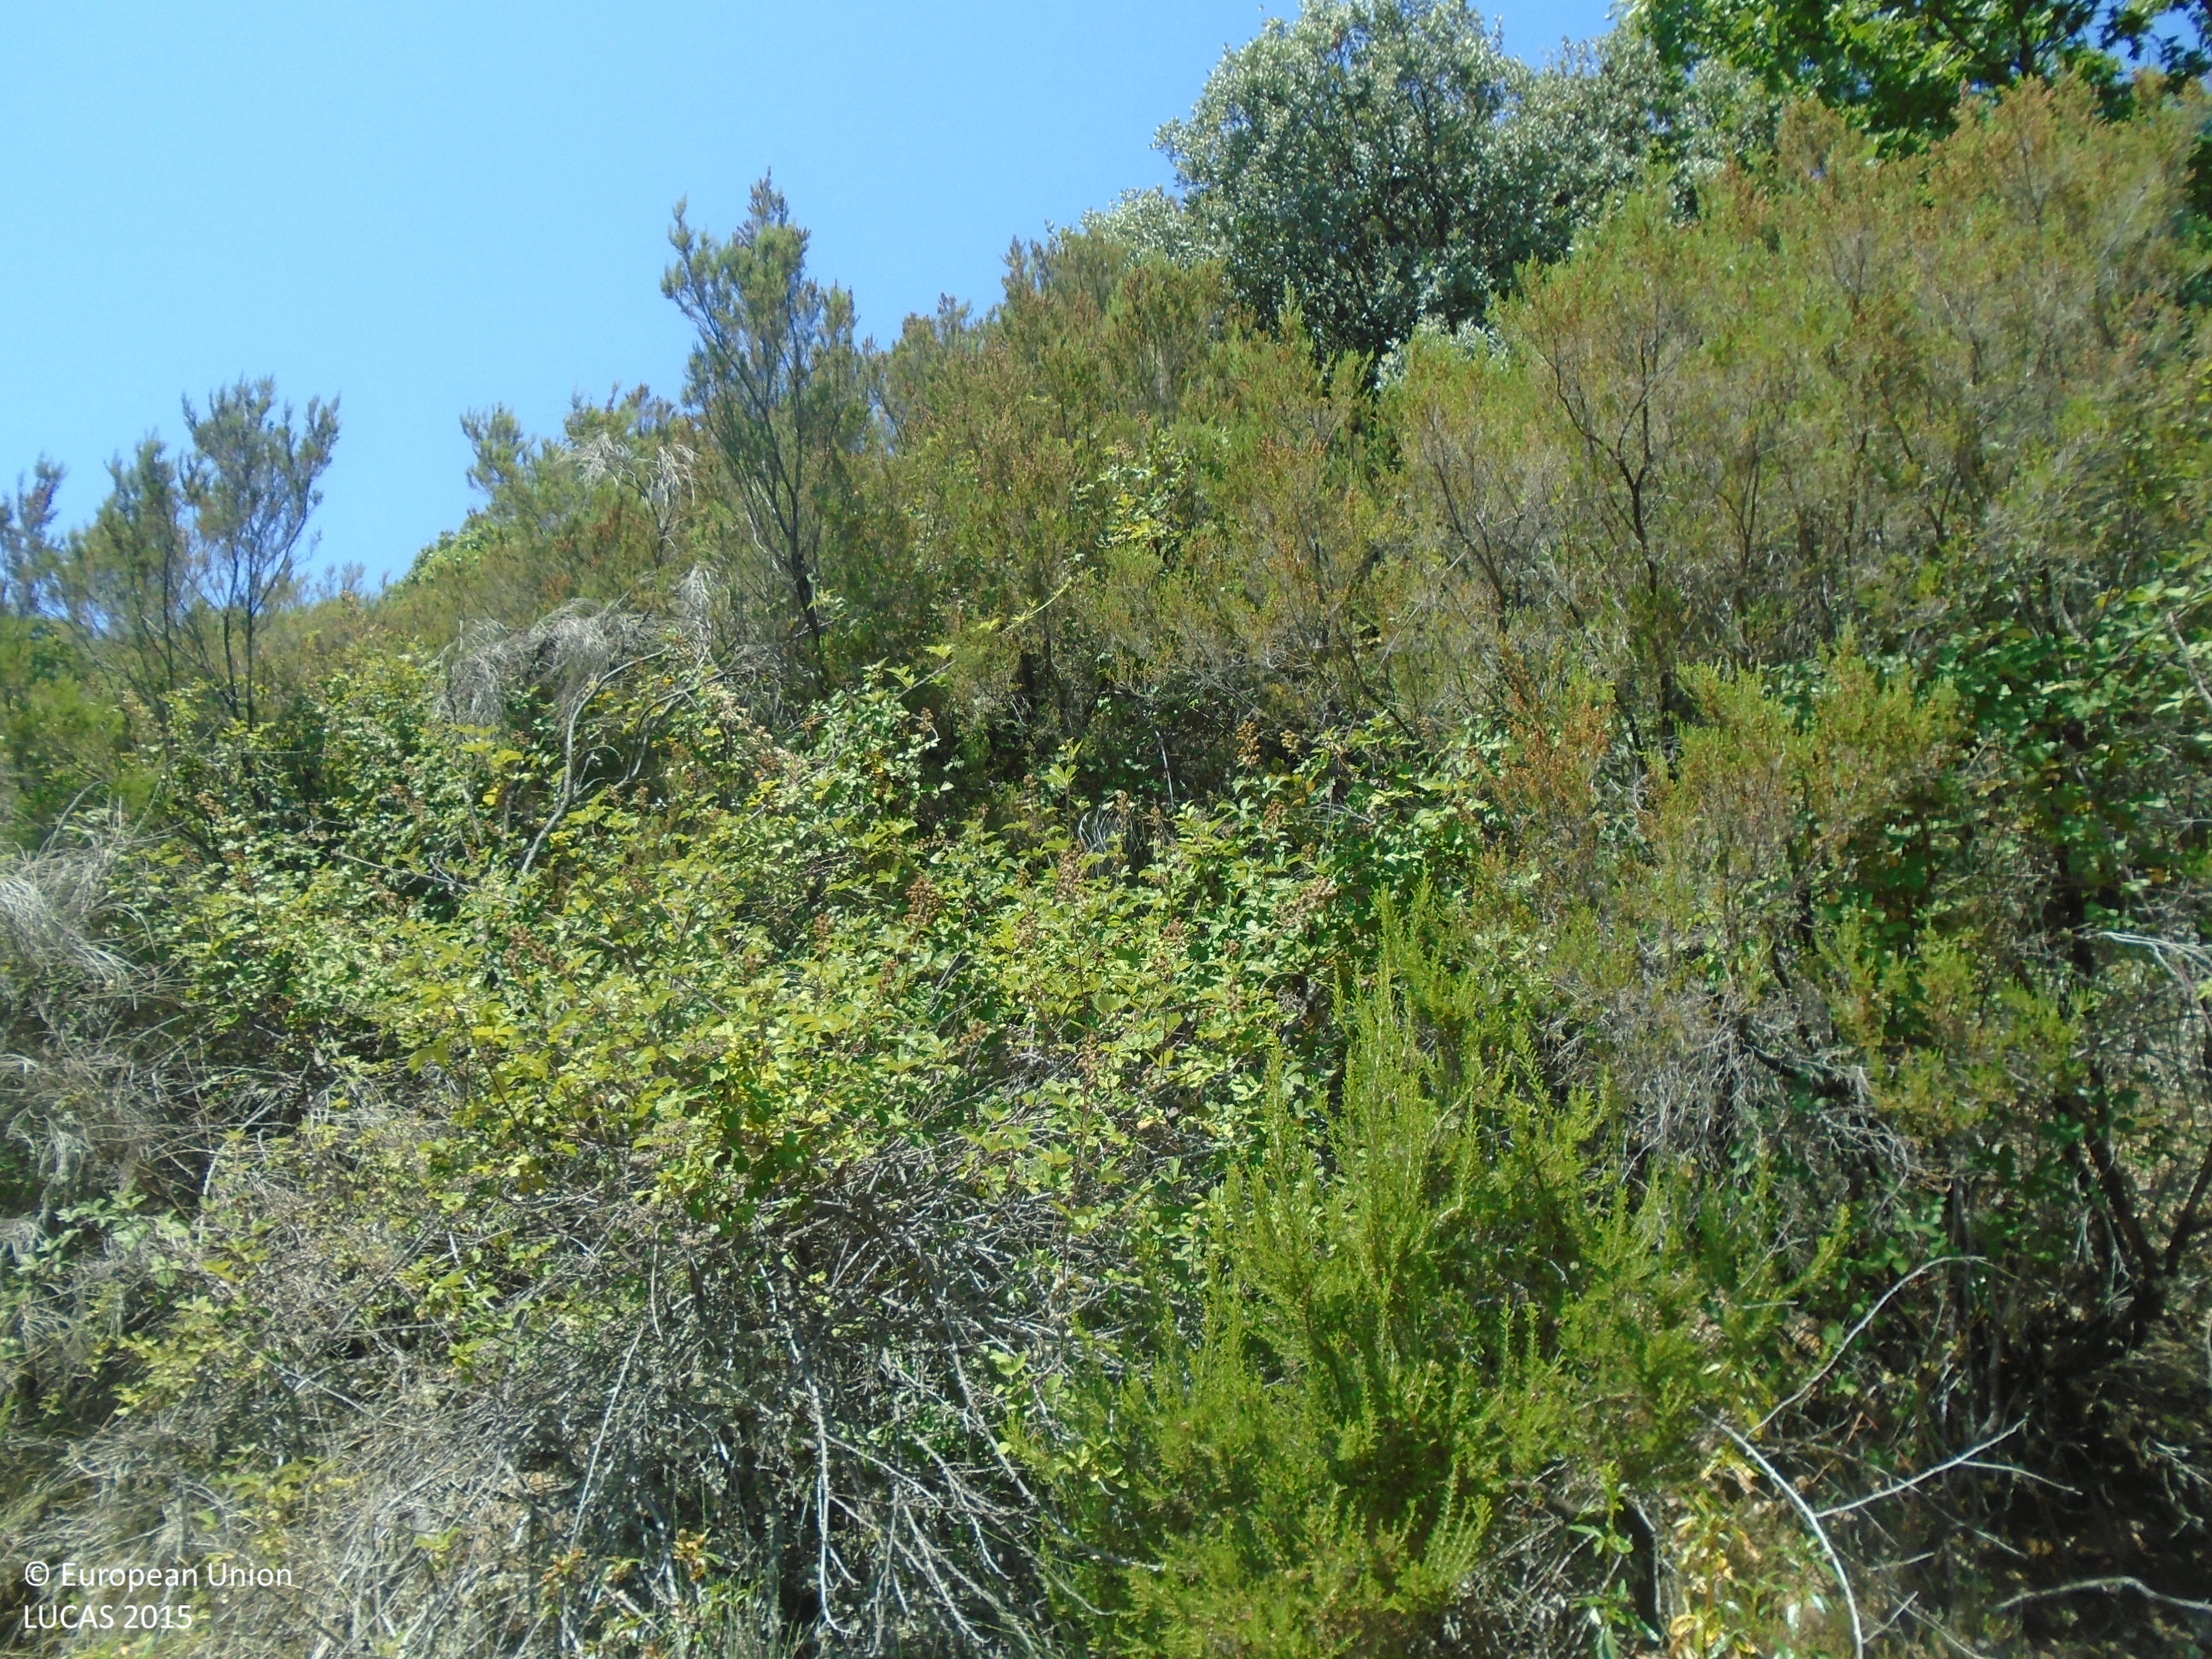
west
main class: Woodland
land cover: Broadleaved woodland
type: broadleaved evergreen forest
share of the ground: 25 - 50 %
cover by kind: broadleaved forest trees 45 %, unconsolidated bare surface 40 %, herbaceous plants 10 %, shrubs 5 %
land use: Semi-natural and natural areas not in use
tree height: > 5 m
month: July
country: ES
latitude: 39.5012
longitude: -4.5852
